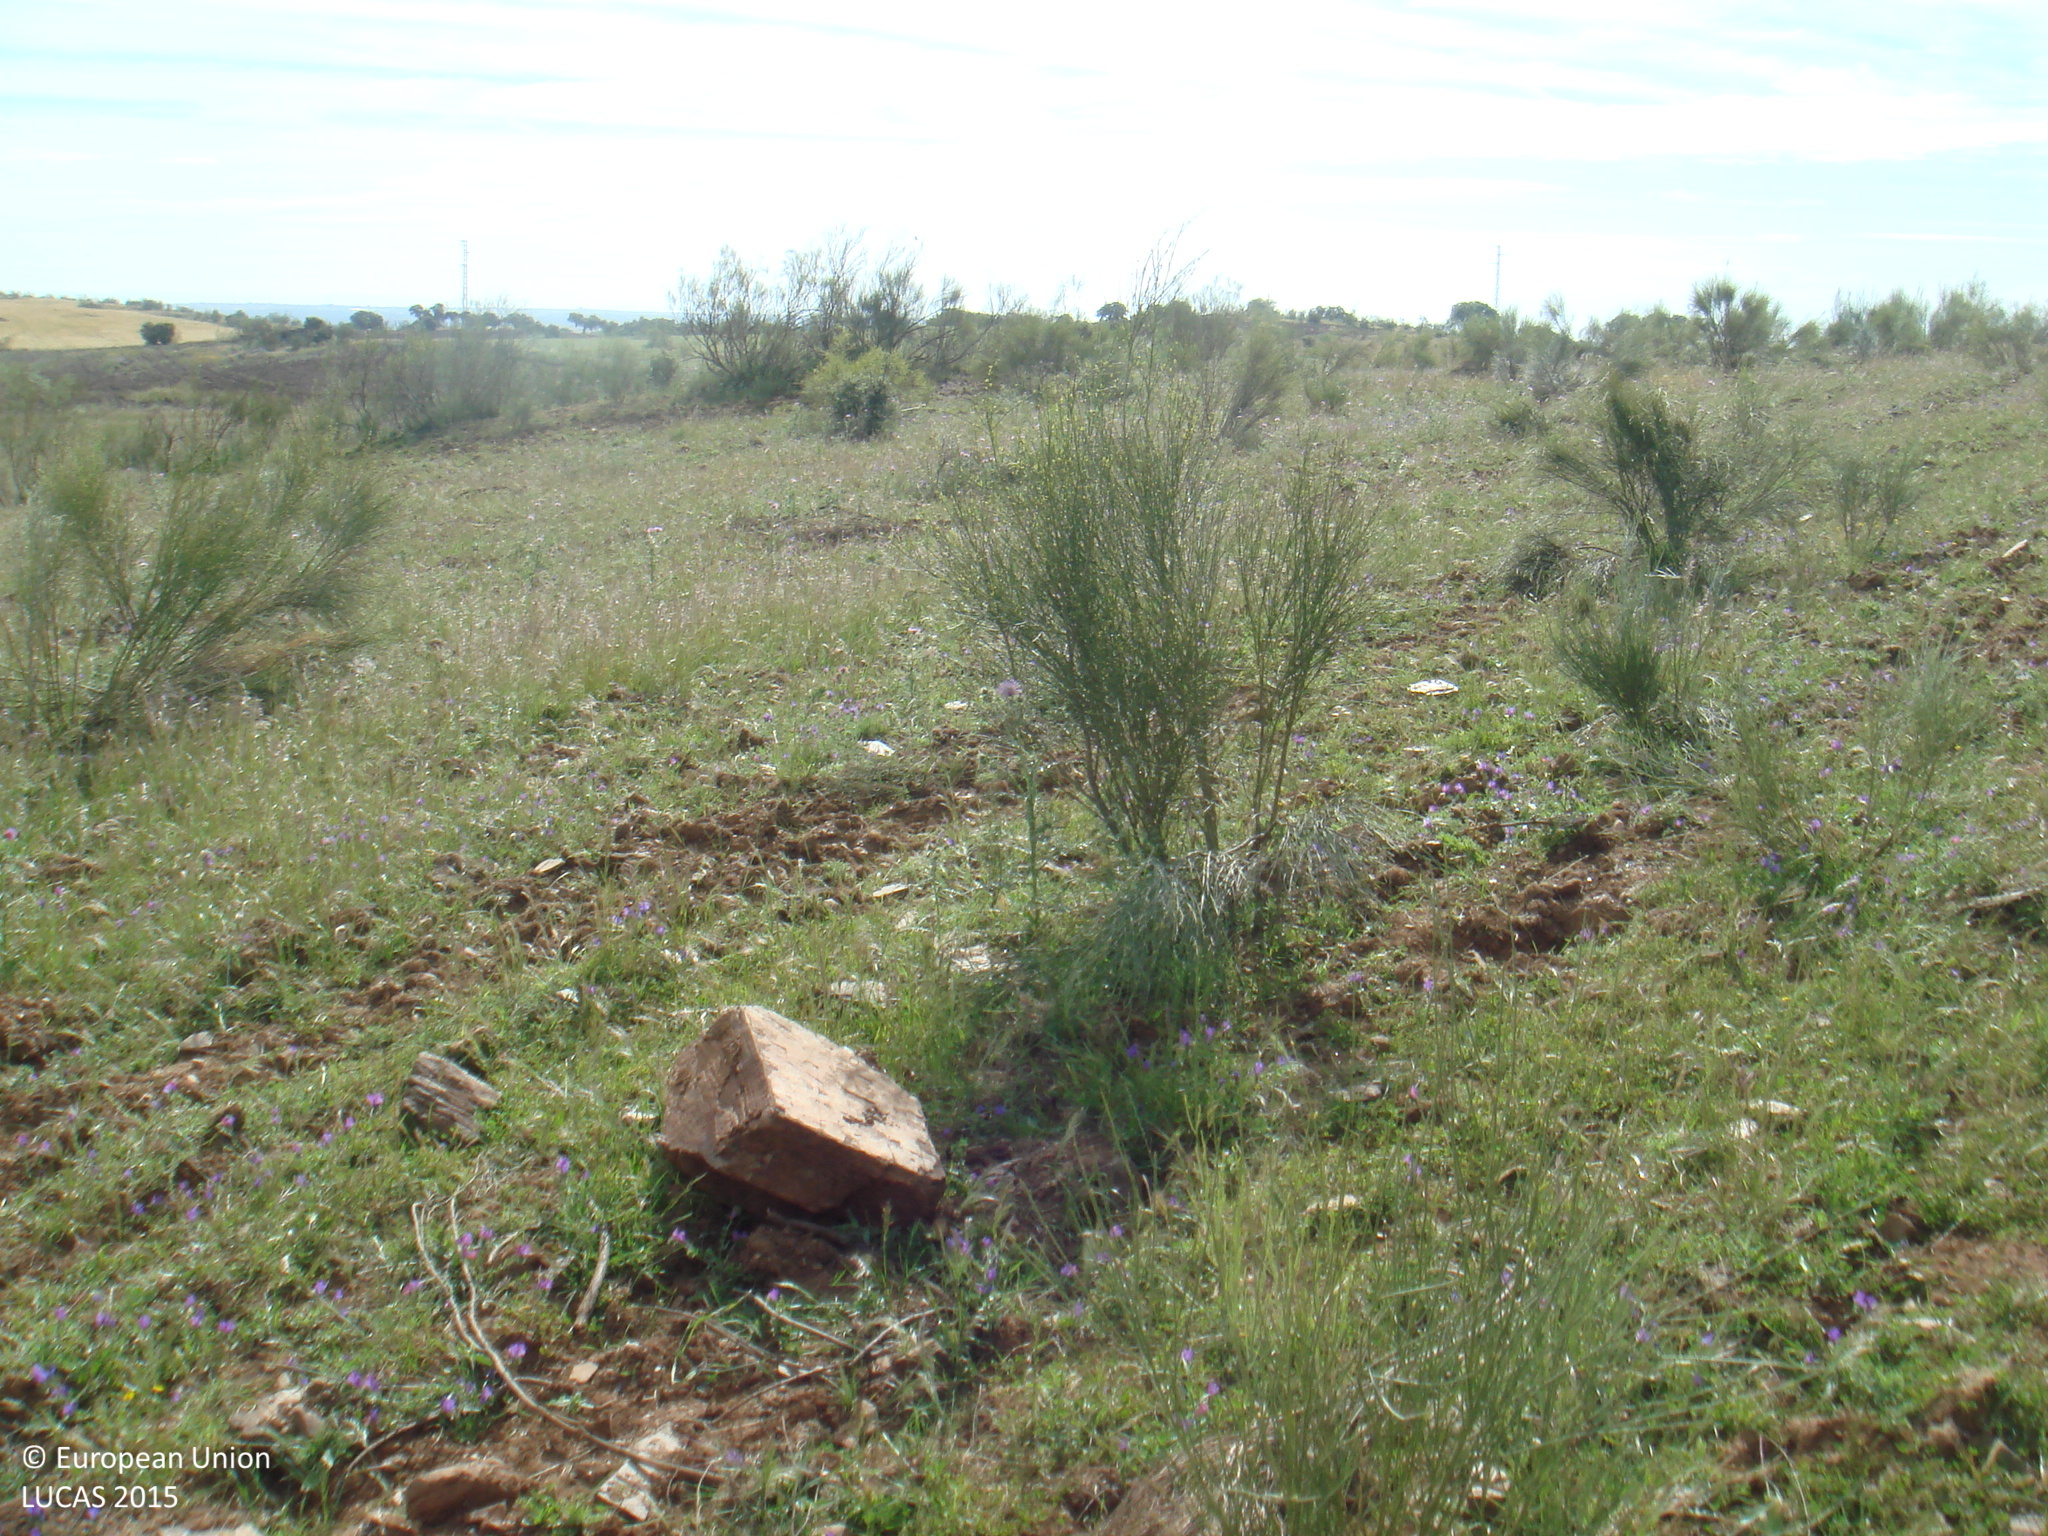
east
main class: Shrubland
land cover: Shrubland without tree cover
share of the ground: > 75 %
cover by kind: herbaceous plants 70 %, shrubs 30 %
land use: Semi-natural and natural areas not in use
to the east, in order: Shrubland without tree cover; Grassland with sparse tree/shrub cover; Spontaneously vegetated surfaces; Grass margins; Fences; Other bare soil; Grass margins; Fences; Grass margins; Mixed cereals for fodder
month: May
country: ES
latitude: 38.4307
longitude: -5.0917
